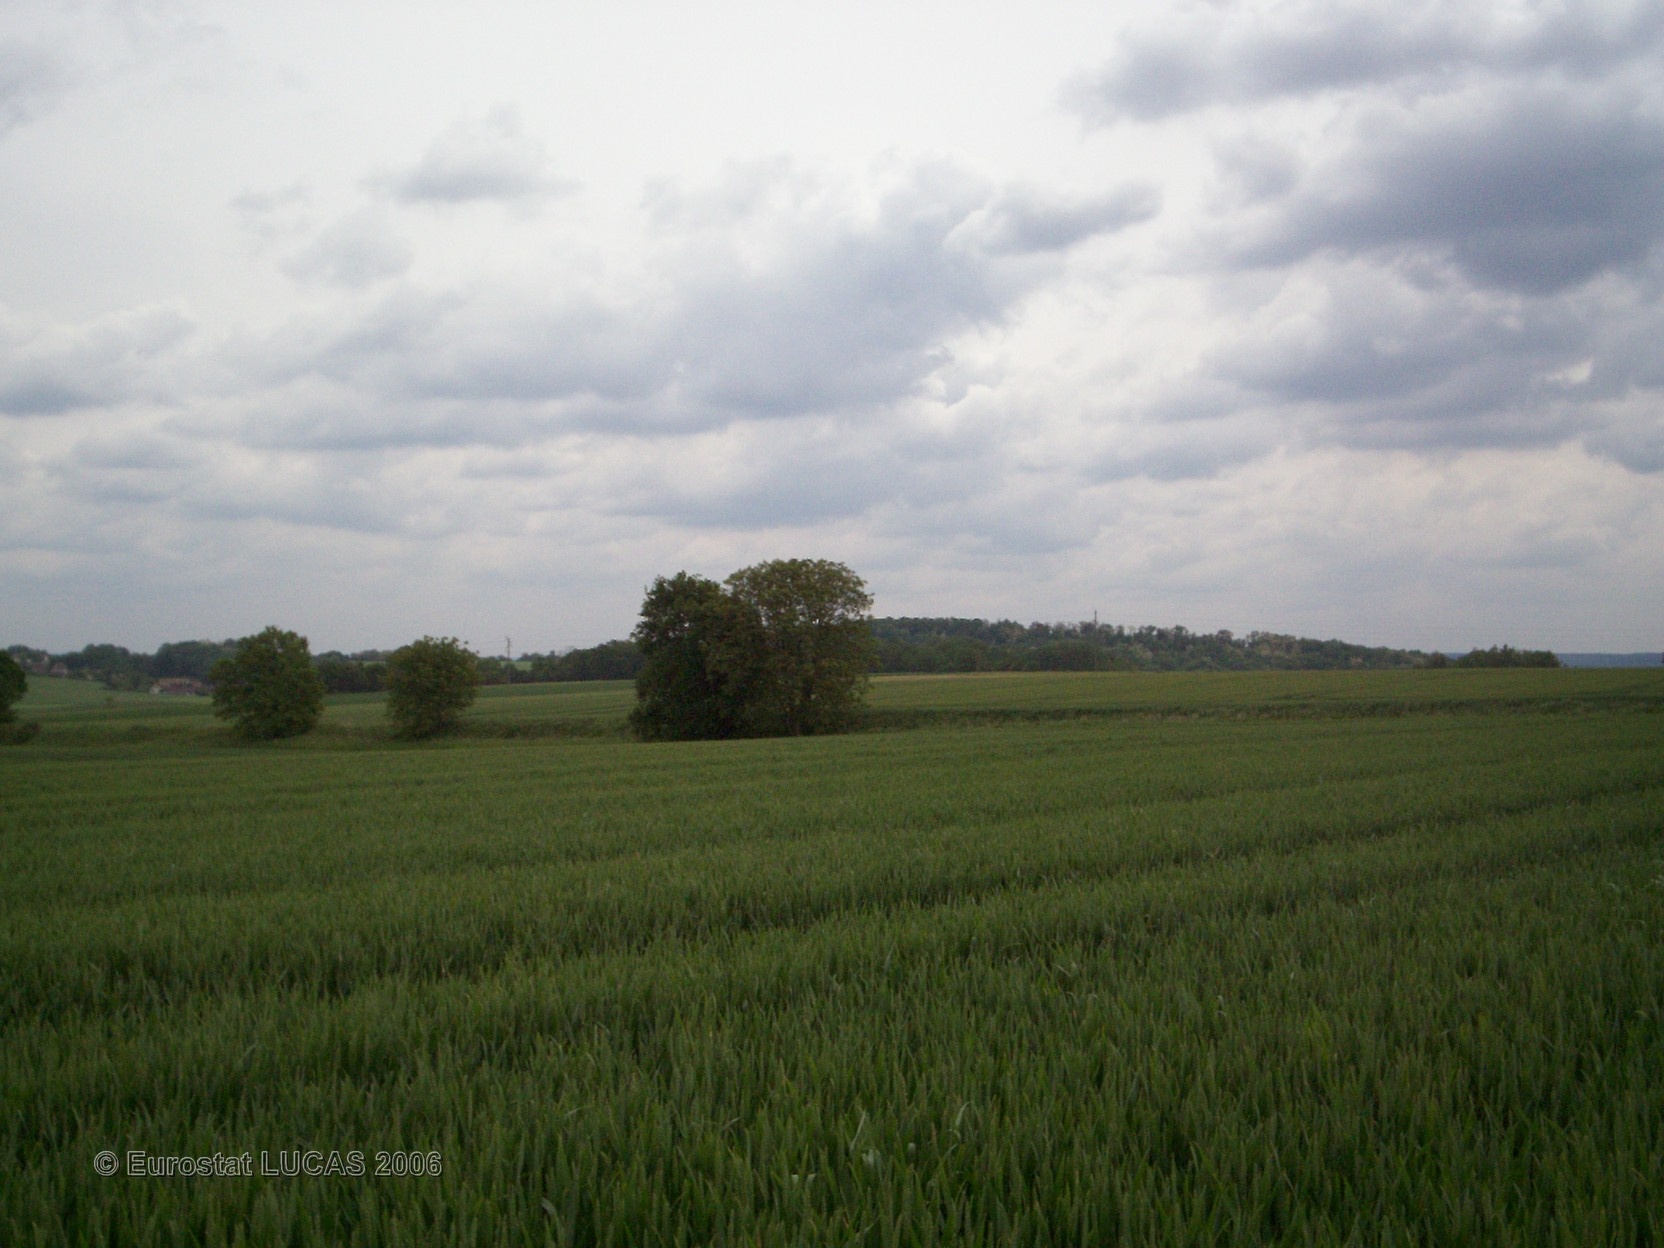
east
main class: Cropland
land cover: Common wheat
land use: Agriculture (excluding fallow land and kitchen gardens)
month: June
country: FR
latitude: 49.3743
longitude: 2.7312
